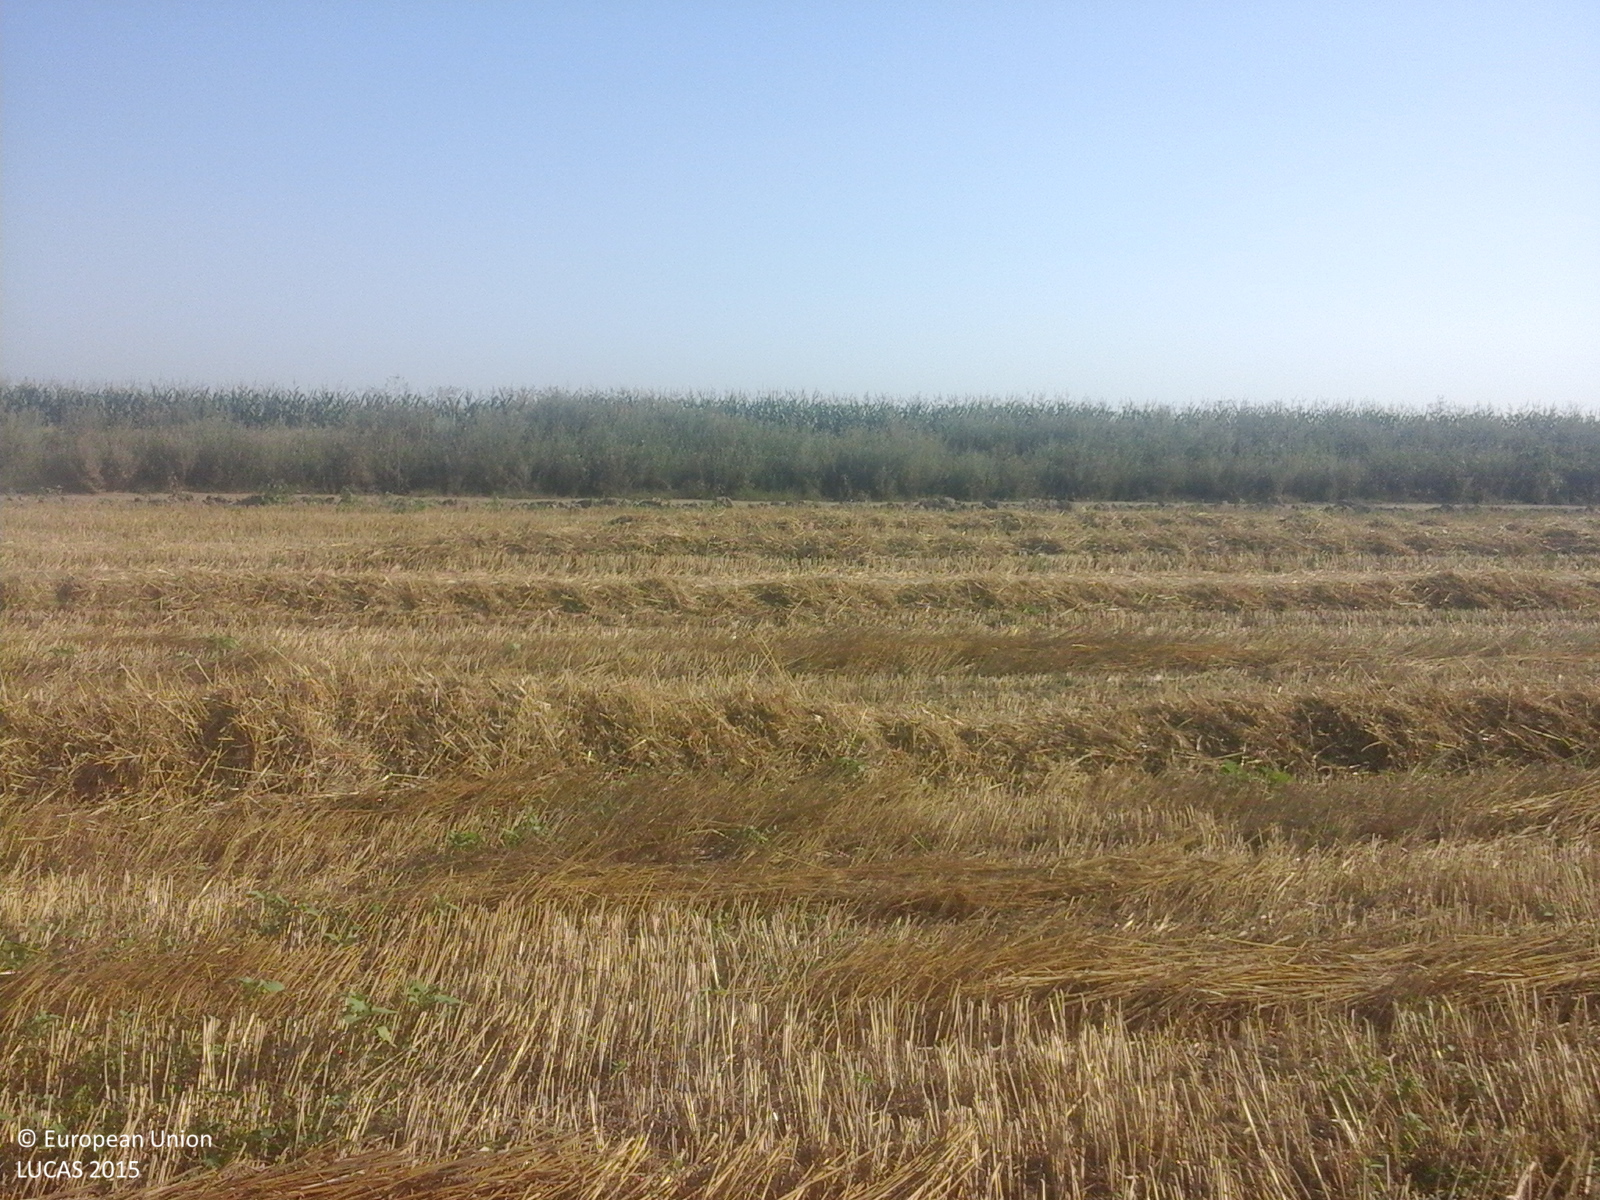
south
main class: Cropland
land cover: Common wheat
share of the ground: 10 - 25 %
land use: Agriculture (excluding fallow land and kitchen gardens)
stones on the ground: < 10 %
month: July
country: RO
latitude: 44.2252
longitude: 27.4255
